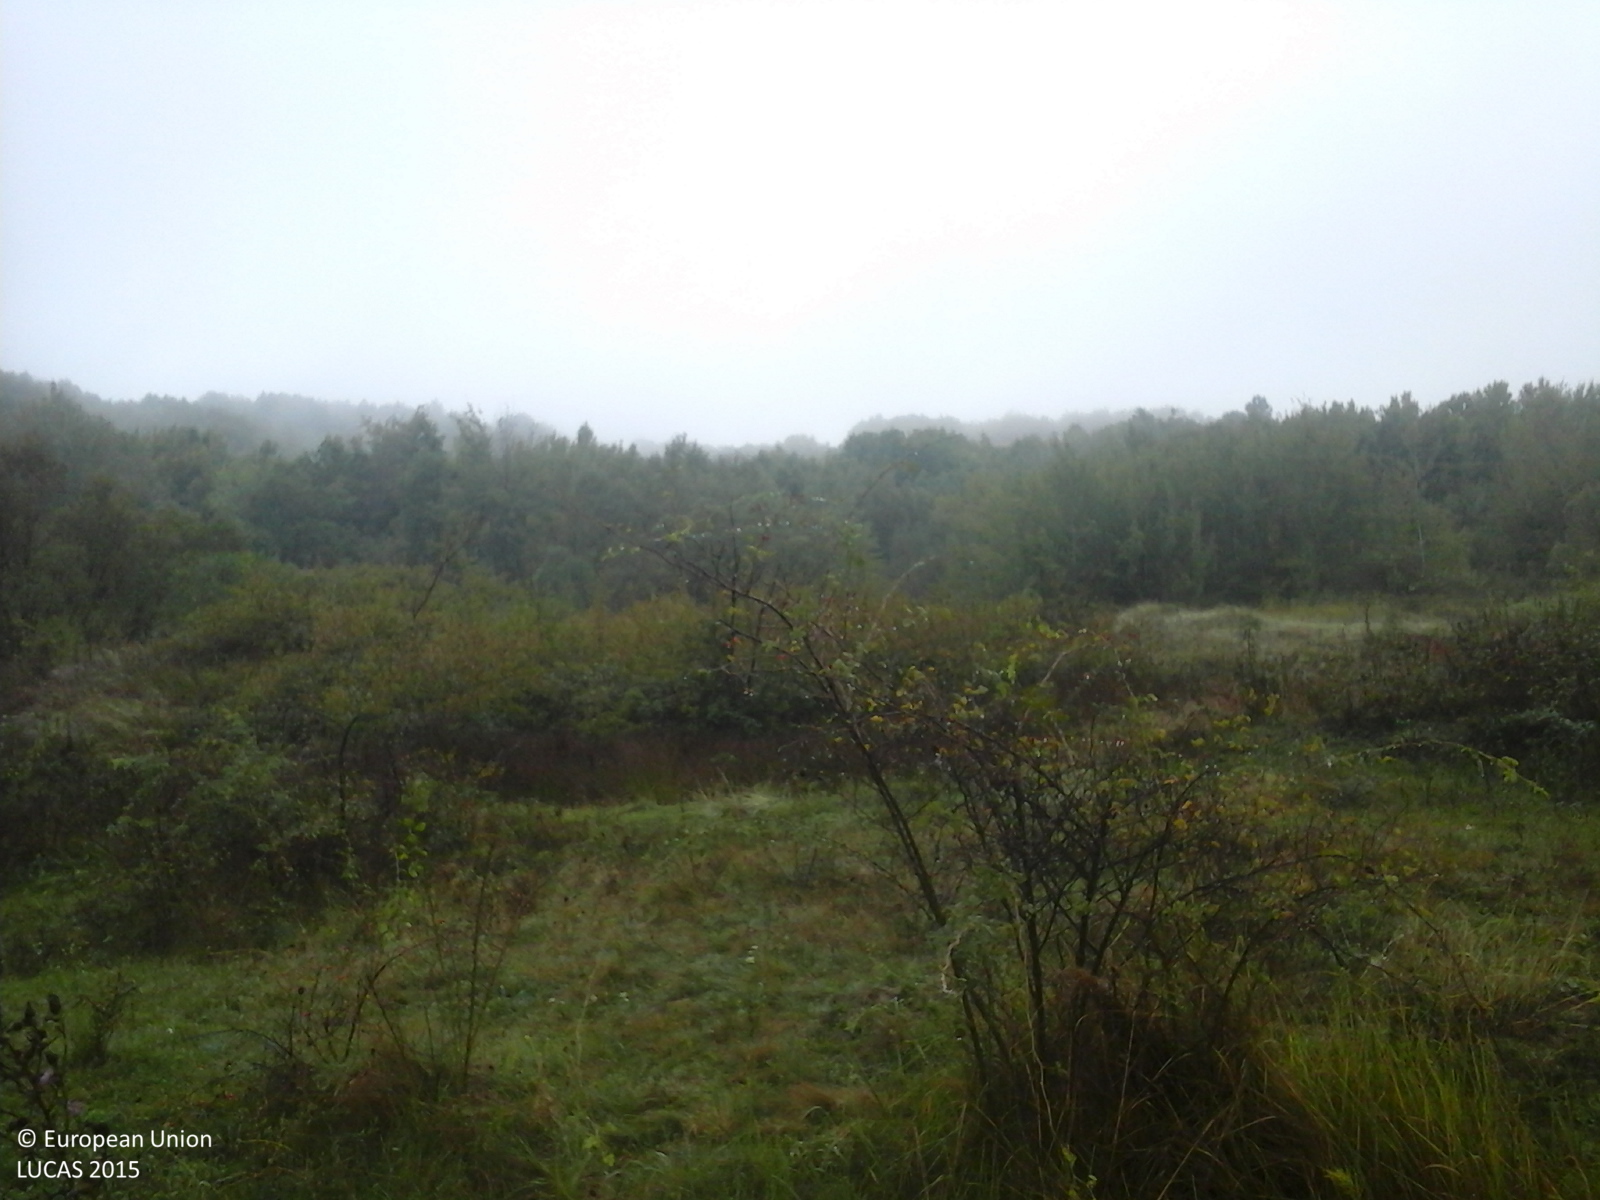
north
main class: Grassland
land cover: Grassland with sparse tree/shrub cover
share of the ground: > 75 %
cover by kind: herbaceous plants 85 %, shrubs 10 %, broadleaved forest trees 5 %
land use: Agriculture (excluding fallow land and kitchen gardens)
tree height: < 5 m
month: September
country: RO
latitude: 44.9937
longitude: 23.6706
